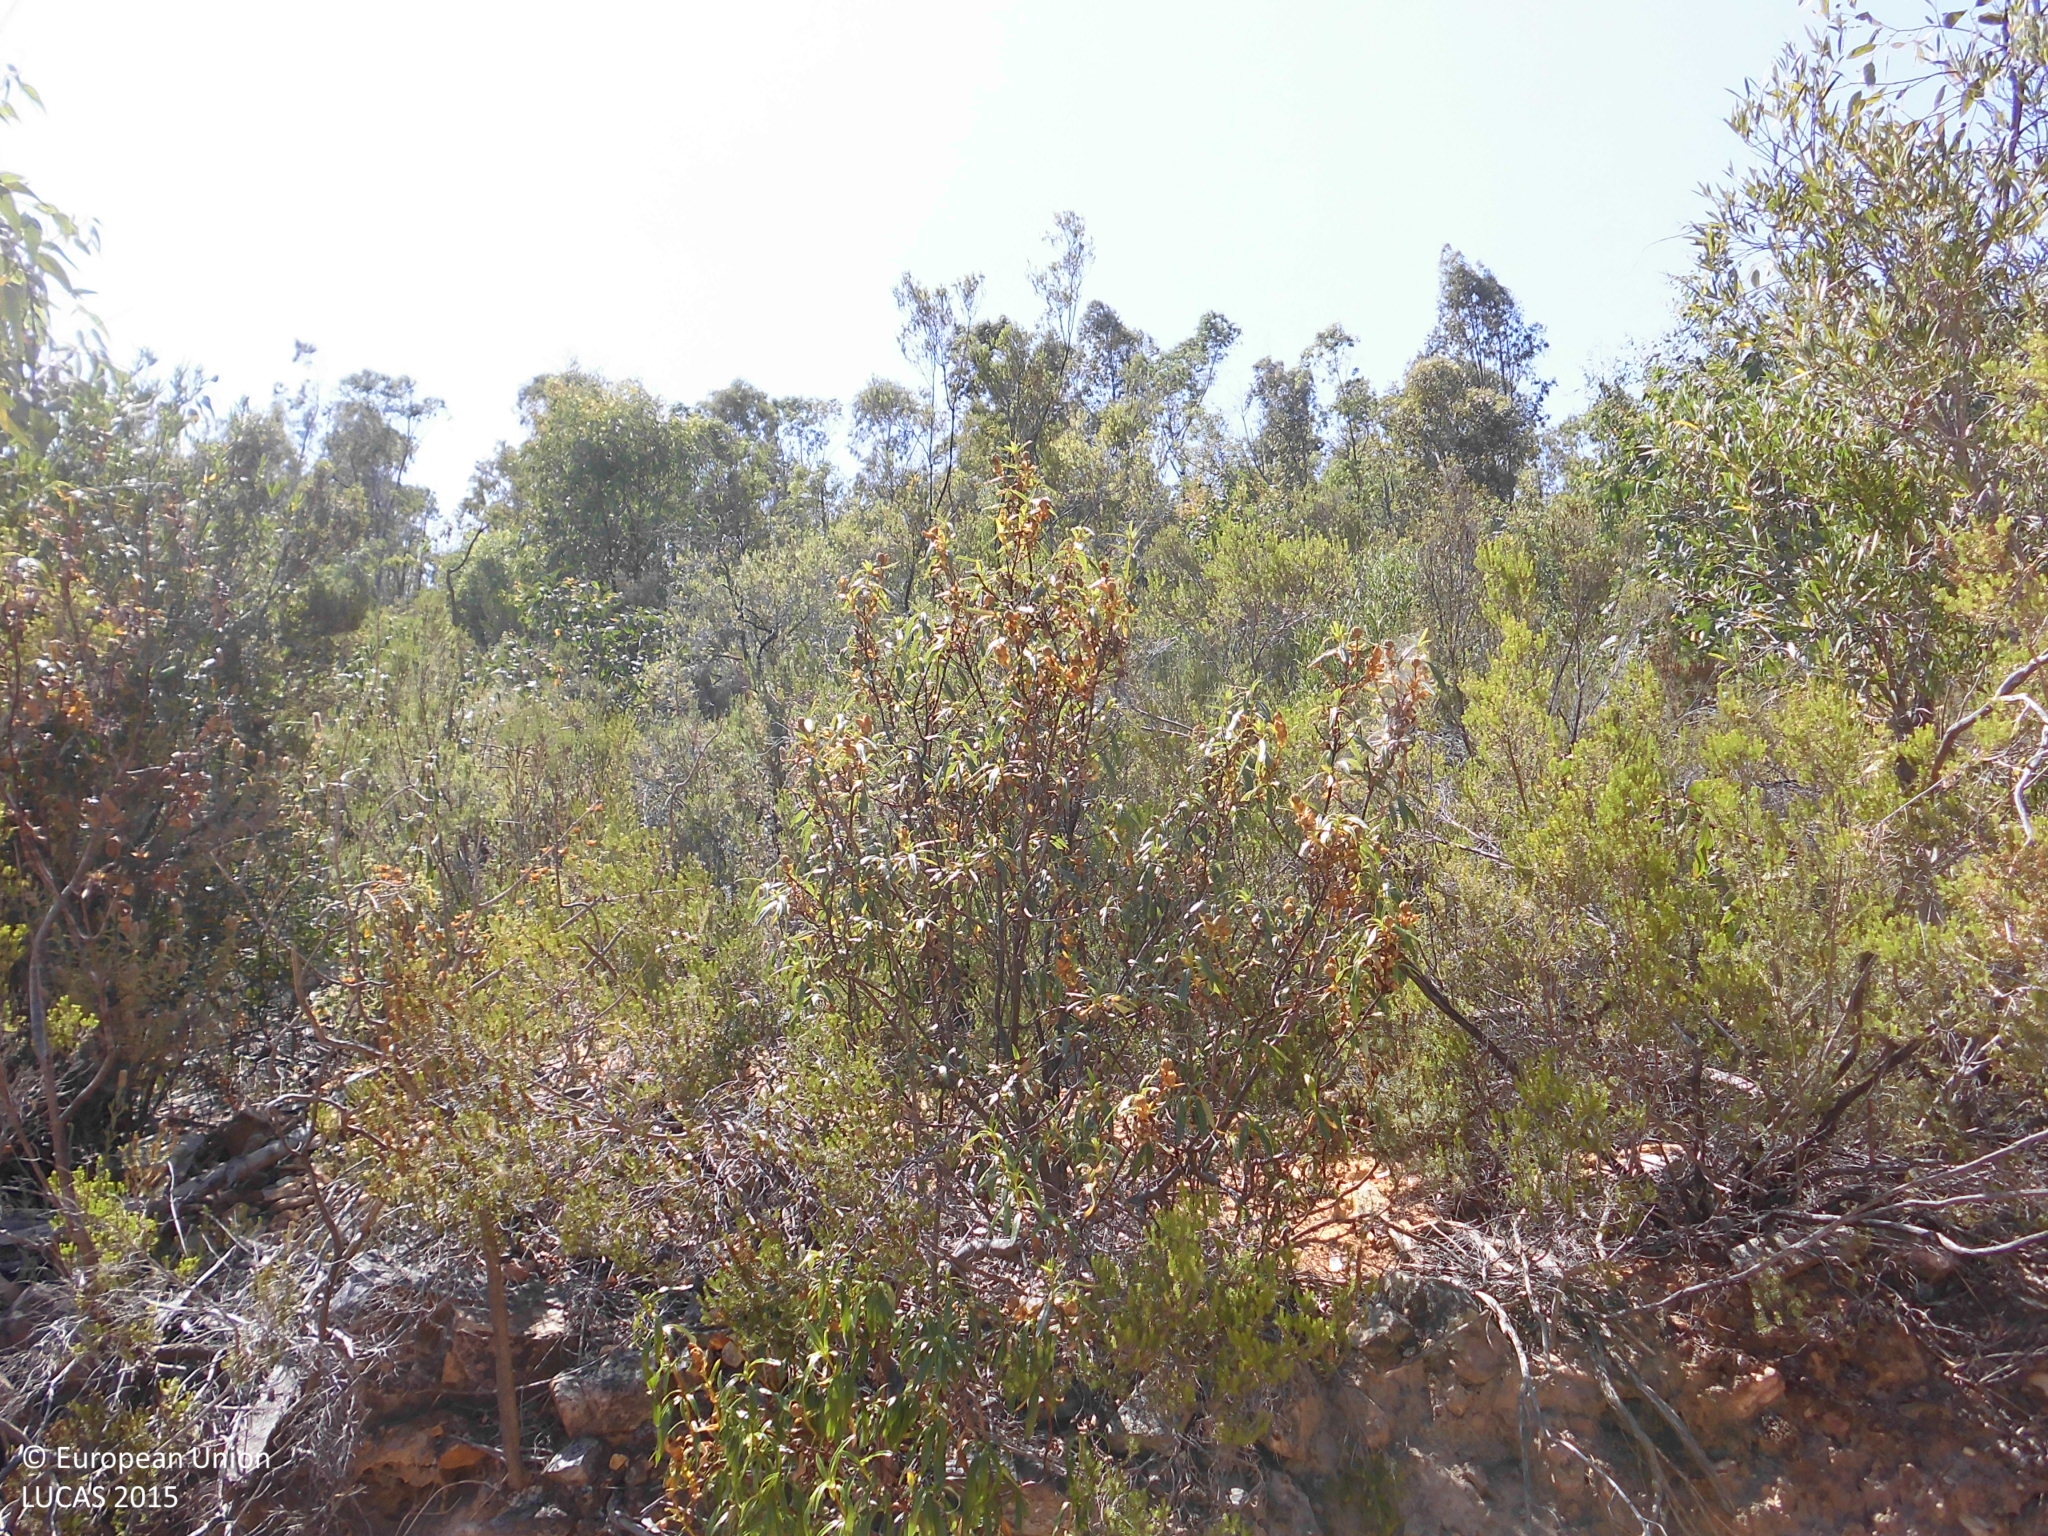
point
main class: Woodland
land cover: Broadleaved woodland
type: exotic forest
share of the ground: 10 - 25 %
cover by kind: shrubs 60 %, broadleaved forest trees 20 %, herbaceous plants 20 %
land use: Forestry
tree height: > 5 m
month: July
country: ES
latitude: 39.7064
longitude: -5.3908
